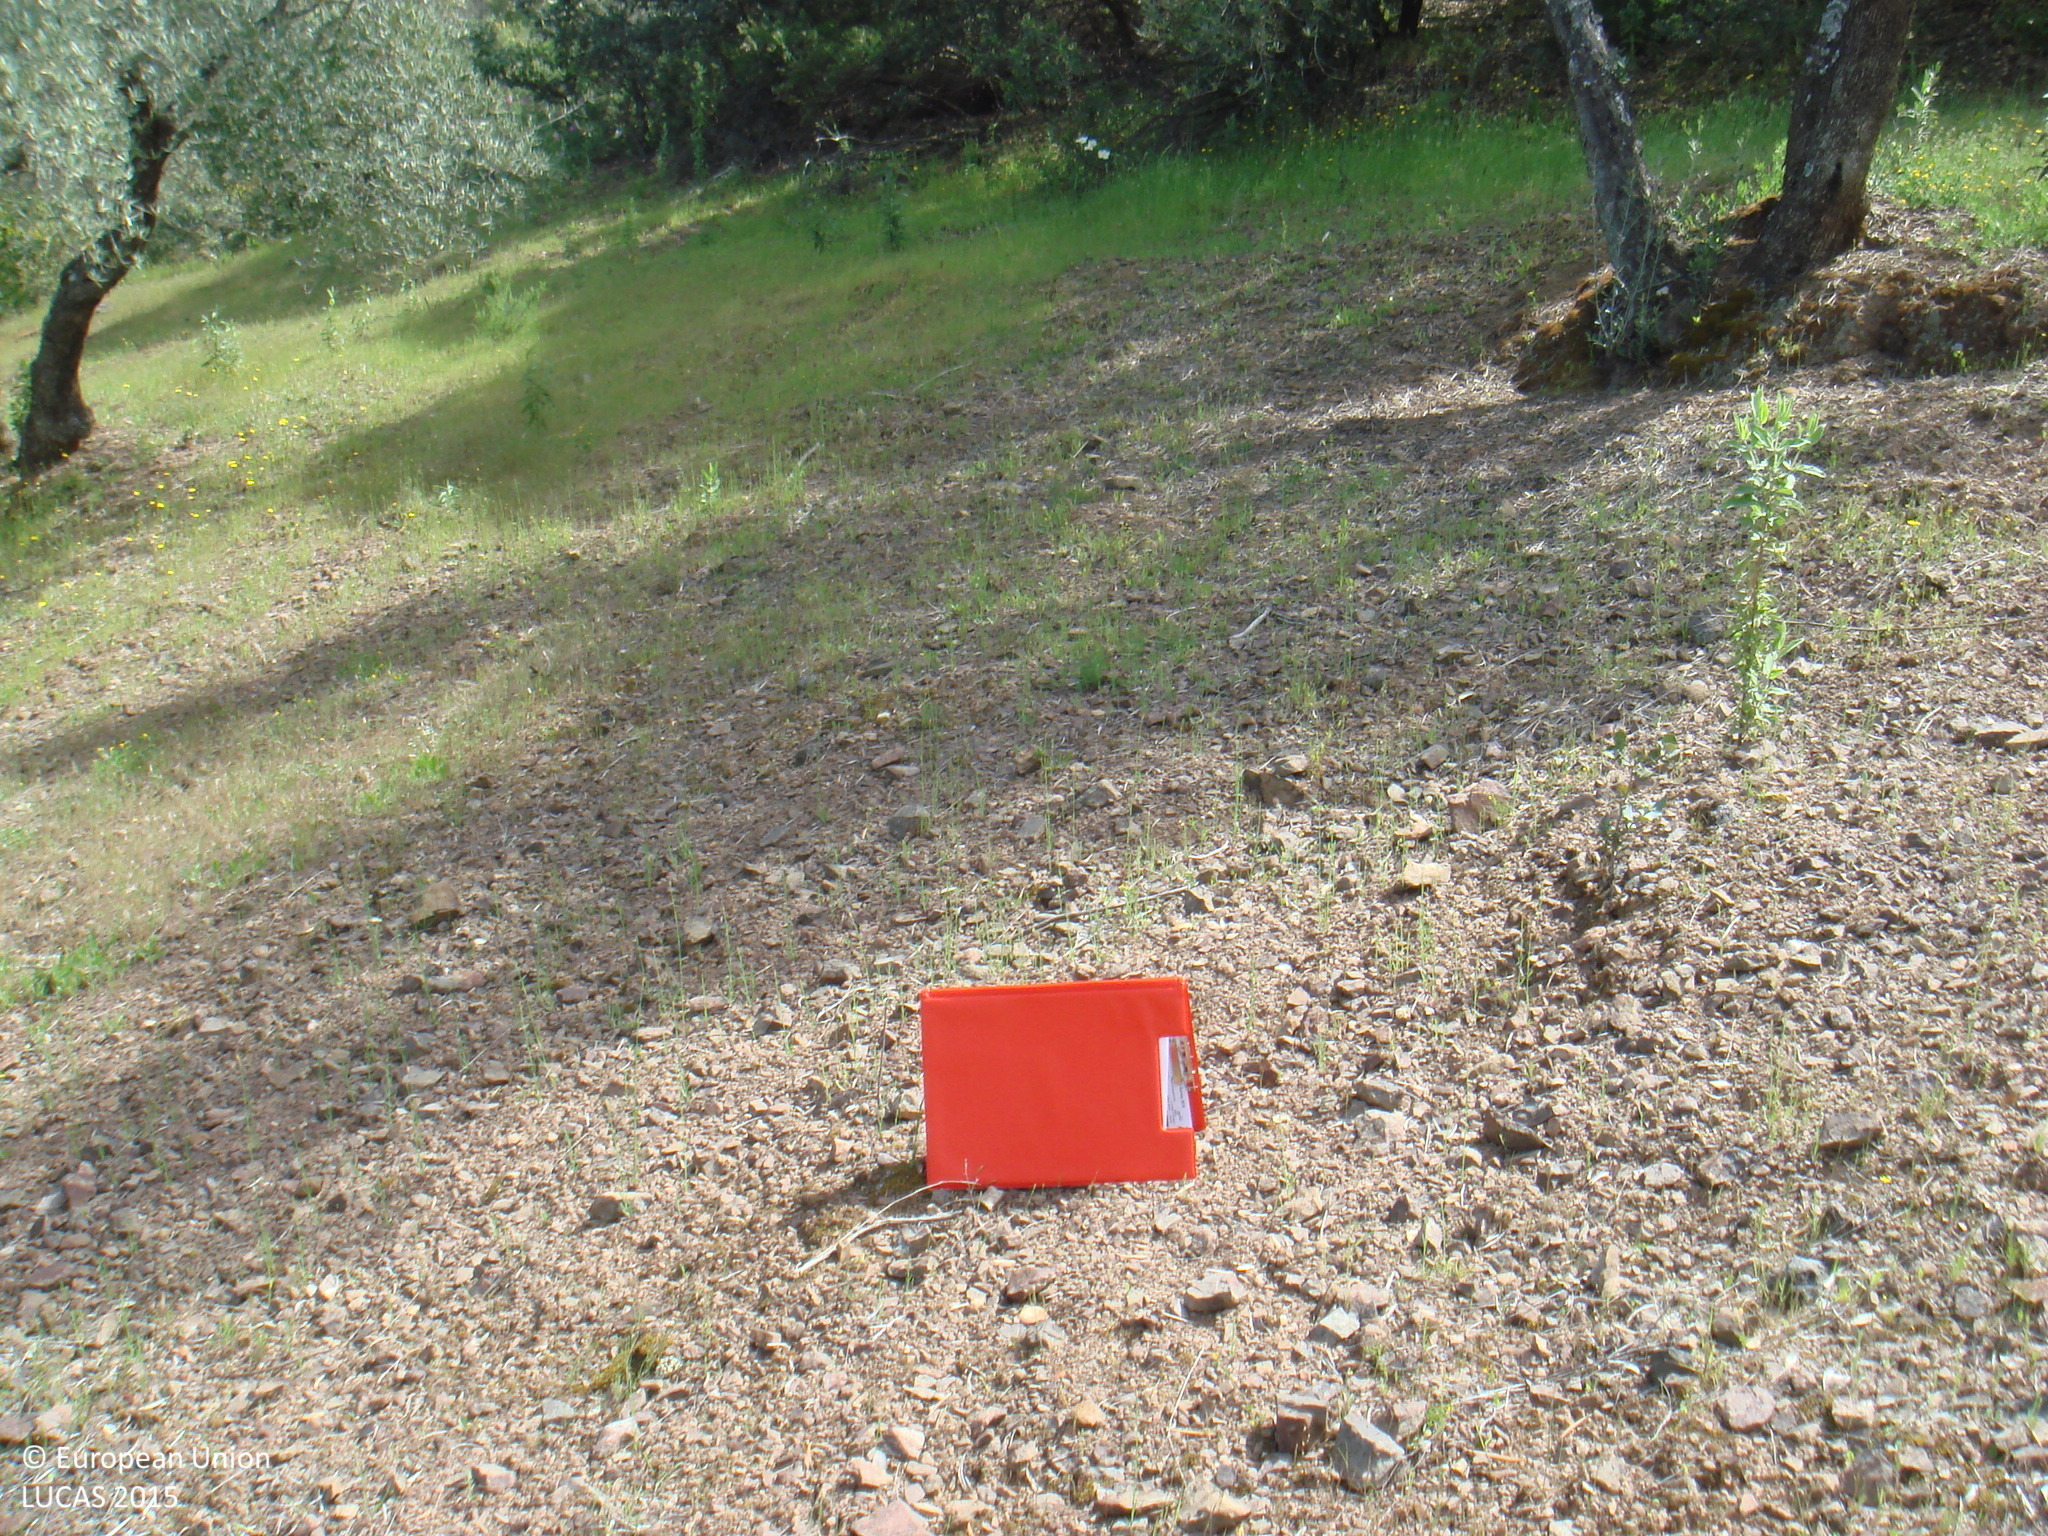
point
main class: Cropland
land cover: Olive groves
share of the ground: 25 - 50 %
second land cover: Spontaneously vegetated surfaces
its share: > 75 %
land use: Agriculture (excluding fallow land and kitchen gardens)
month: April
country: ES
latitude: 38.1604
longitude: -4.7064
